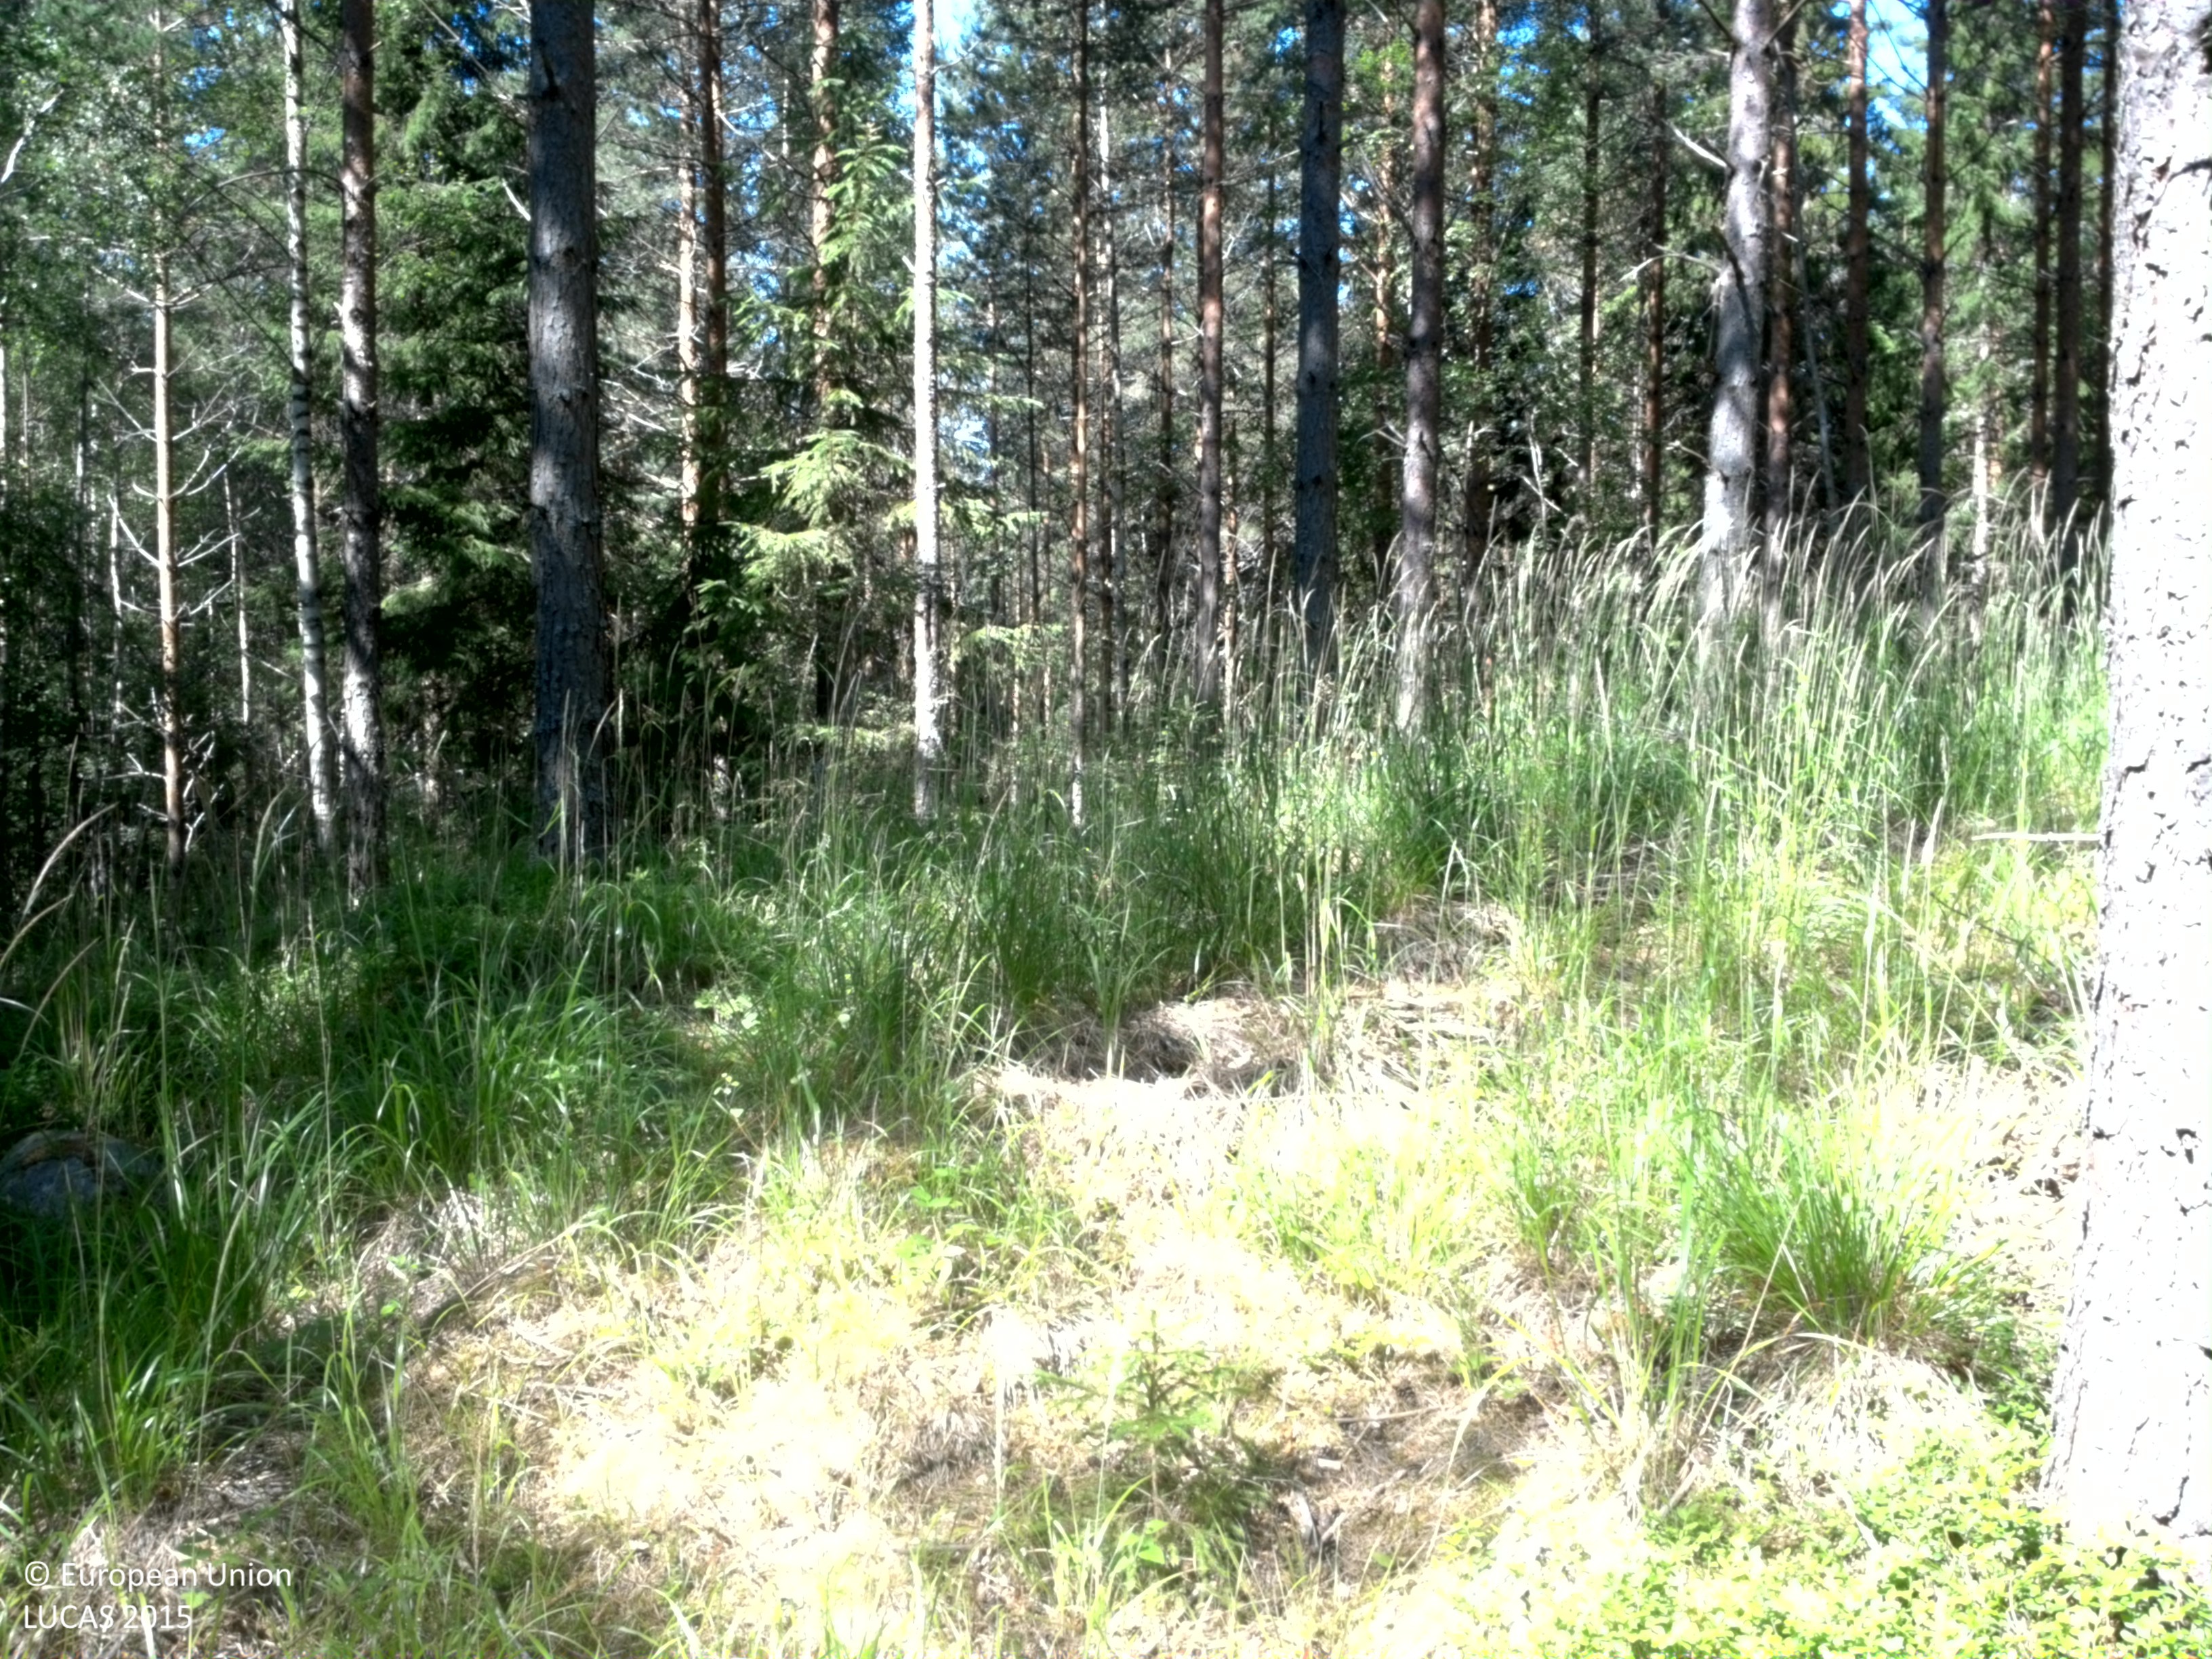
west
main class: Woodland
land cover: Pine dominated coniferous woodland
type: boreal forest
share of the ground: 50 - 75 %
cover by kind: coniferous forest trees 40 %, herbaceous plants 35 %, broadleaved forest trees 10 %, shrubs 10 %, lichens and mosses 5 %
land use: Forestry
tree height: > 5 m
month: July
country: SE
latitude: 59.6518
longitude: 14.6927
